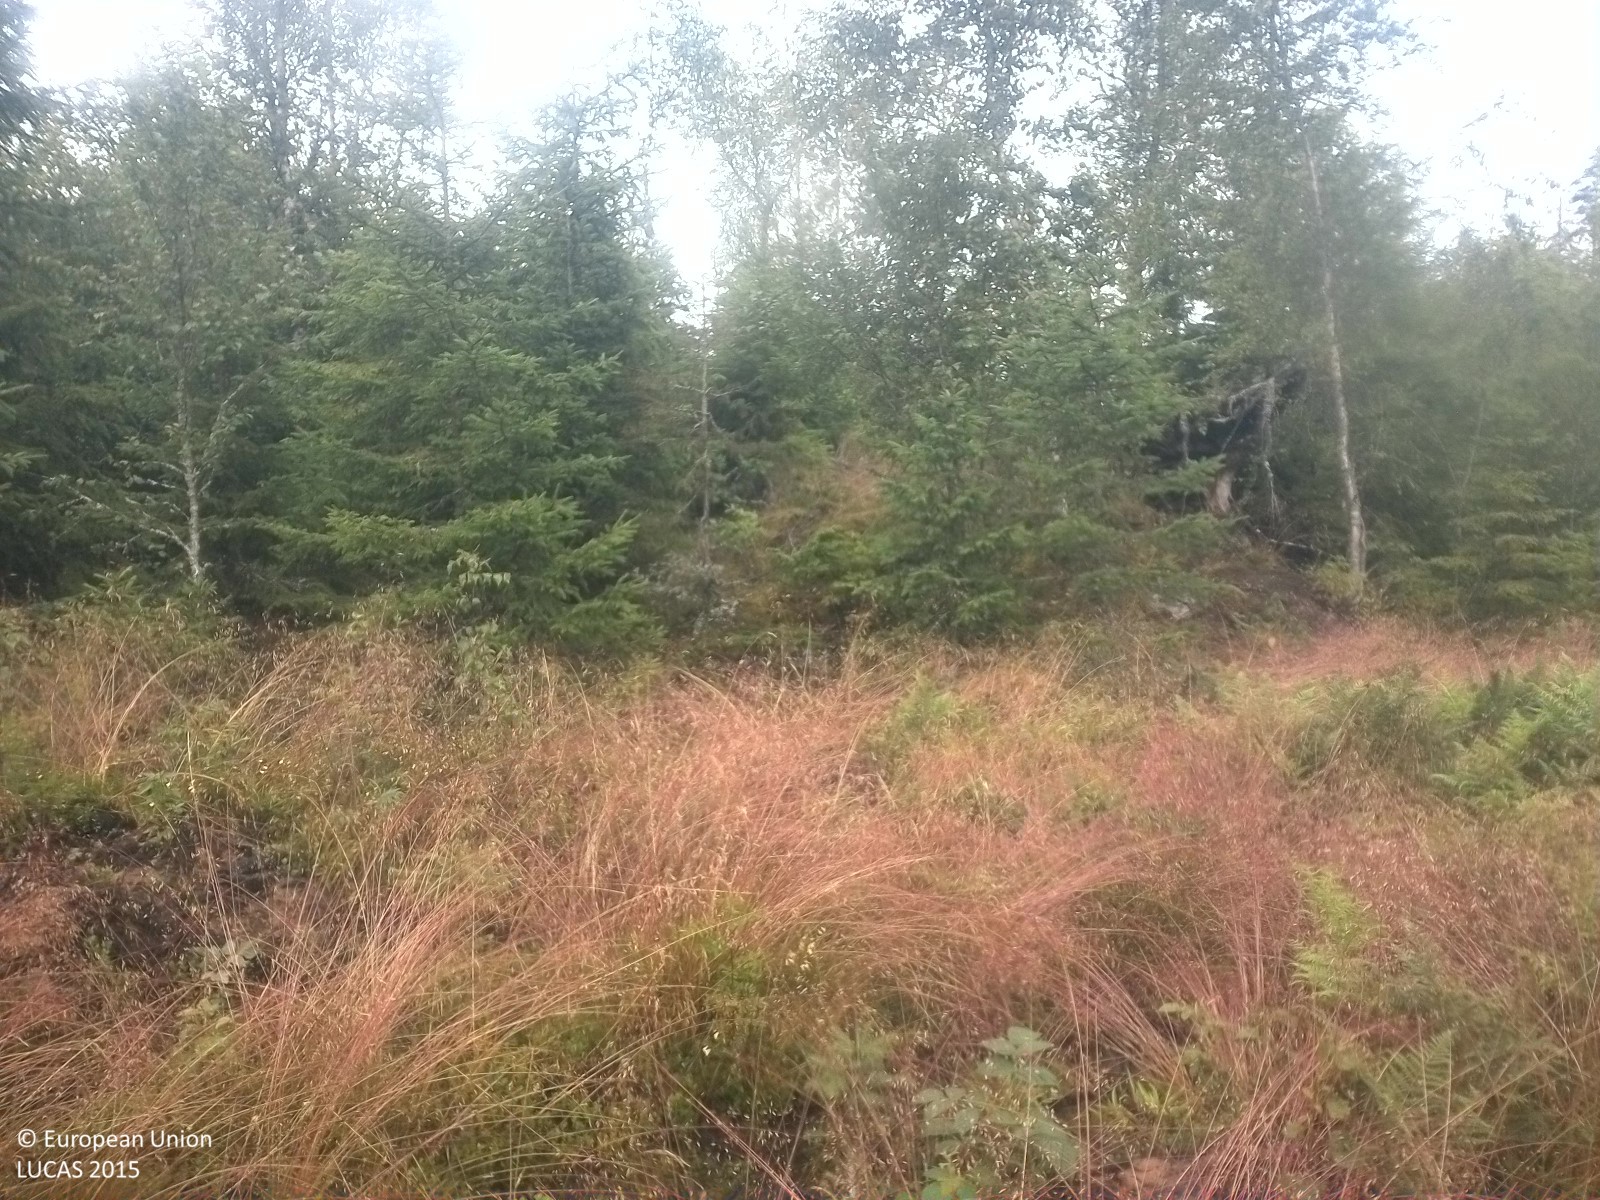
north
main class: Woodland
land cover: Spruce dominated coniferous woodland
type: boreal forest
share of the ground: 10 - 25 %
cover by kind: herbaceous plants 60 %, coniferous forest trees 20 %, shrubs 20 %
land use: Forestry
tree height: < 5 m
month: July
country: SE
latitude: 58.9973
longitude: 14.8486
